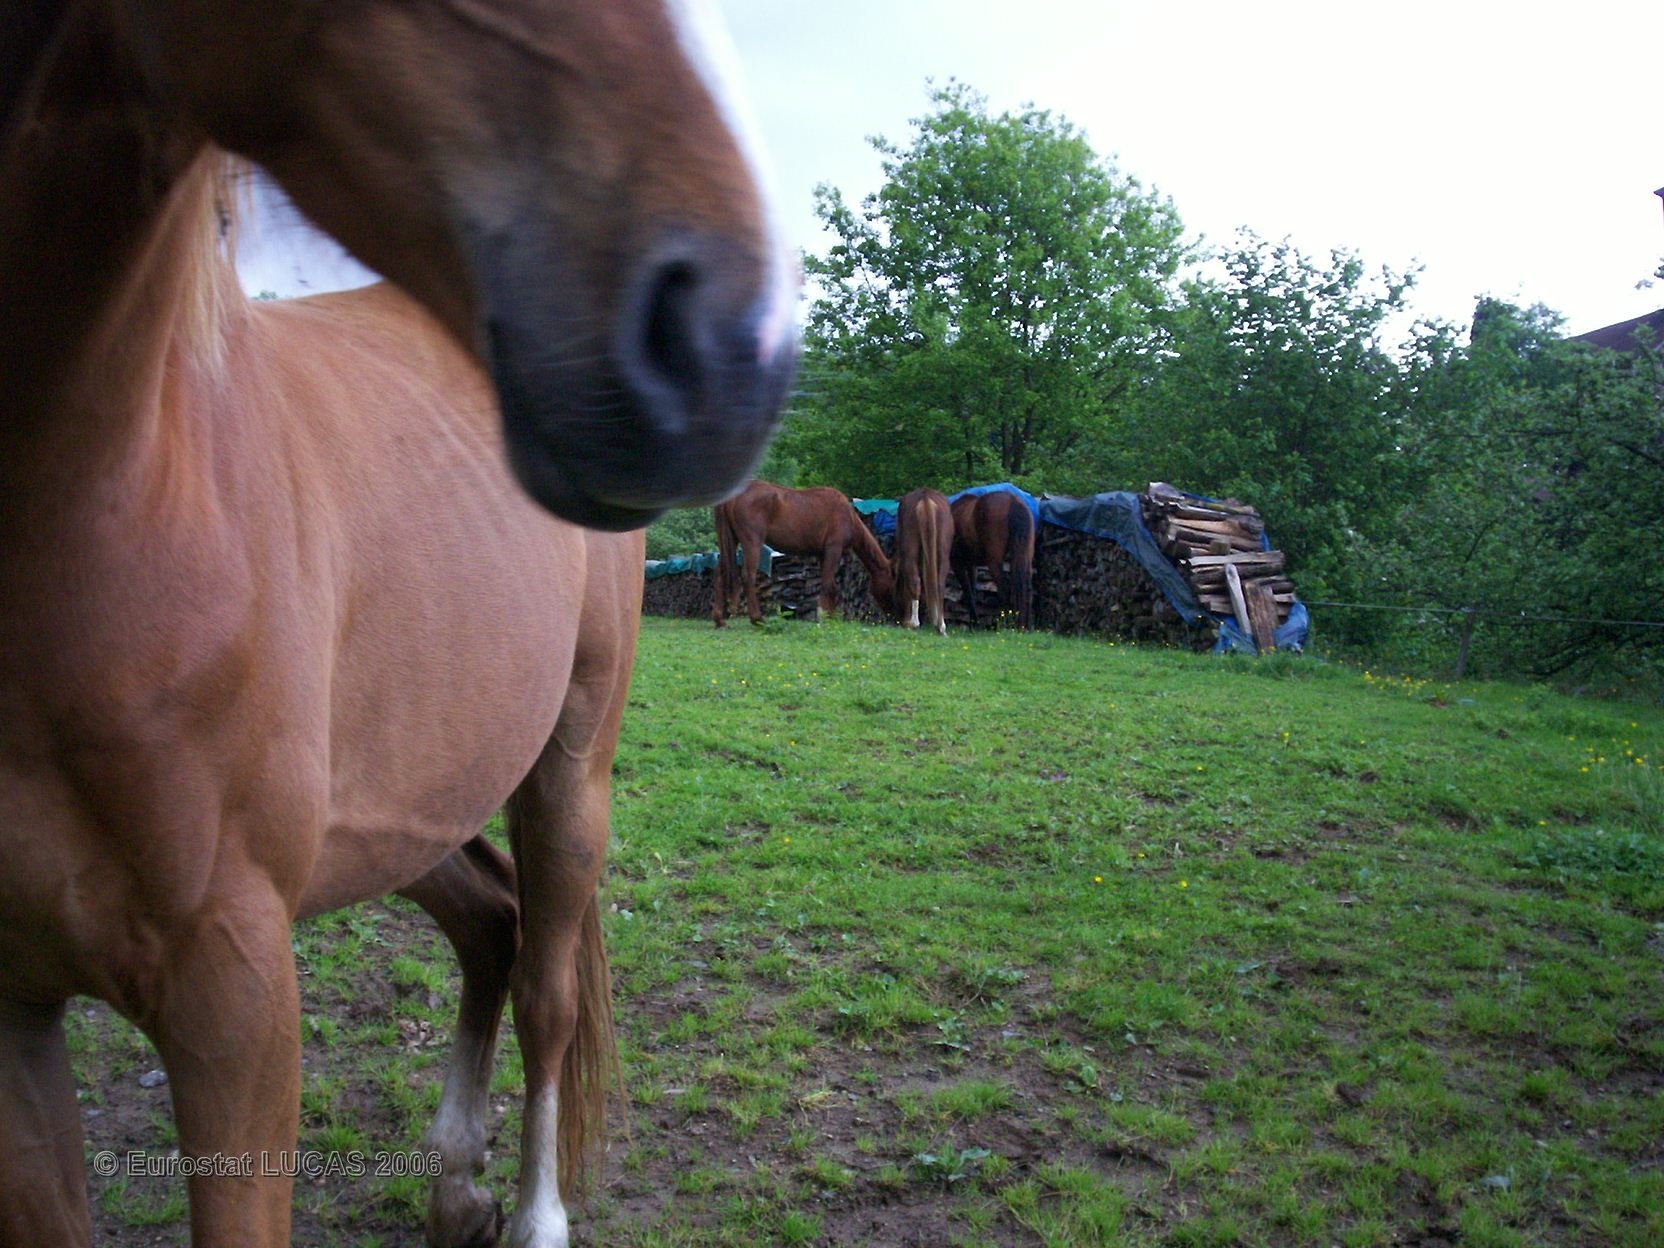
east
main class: Grassland
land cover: Grassland without tree/shrub cover
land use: Agriculture (excluding fallow land and kitchen gardens)
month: May
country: FR
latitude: 48.2935
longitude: 7.1029
